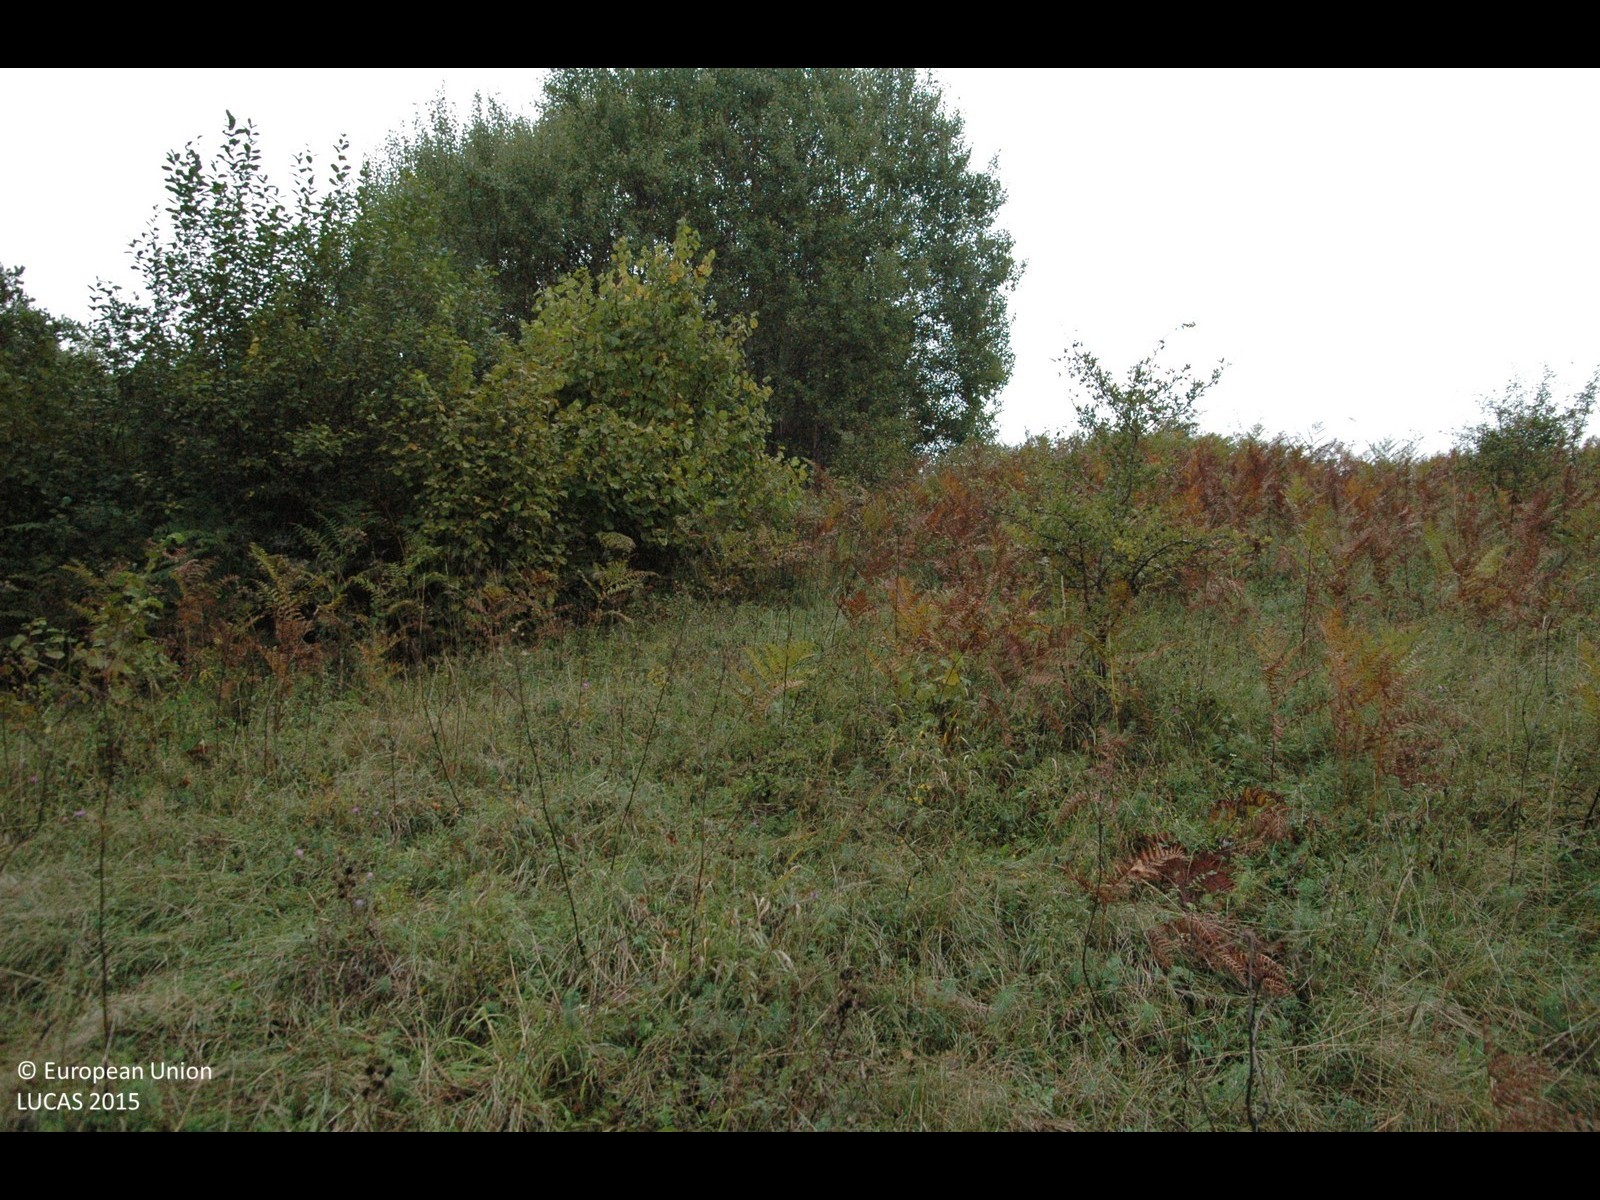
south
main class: Grassland
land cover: Grassland without tree/shrub cover
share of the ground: > 75 %
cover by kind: herbaceous plants 100 %
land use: Semi-natural and natural areas not in use
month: September
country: HR
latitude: 45.0463
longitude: 15.6449
